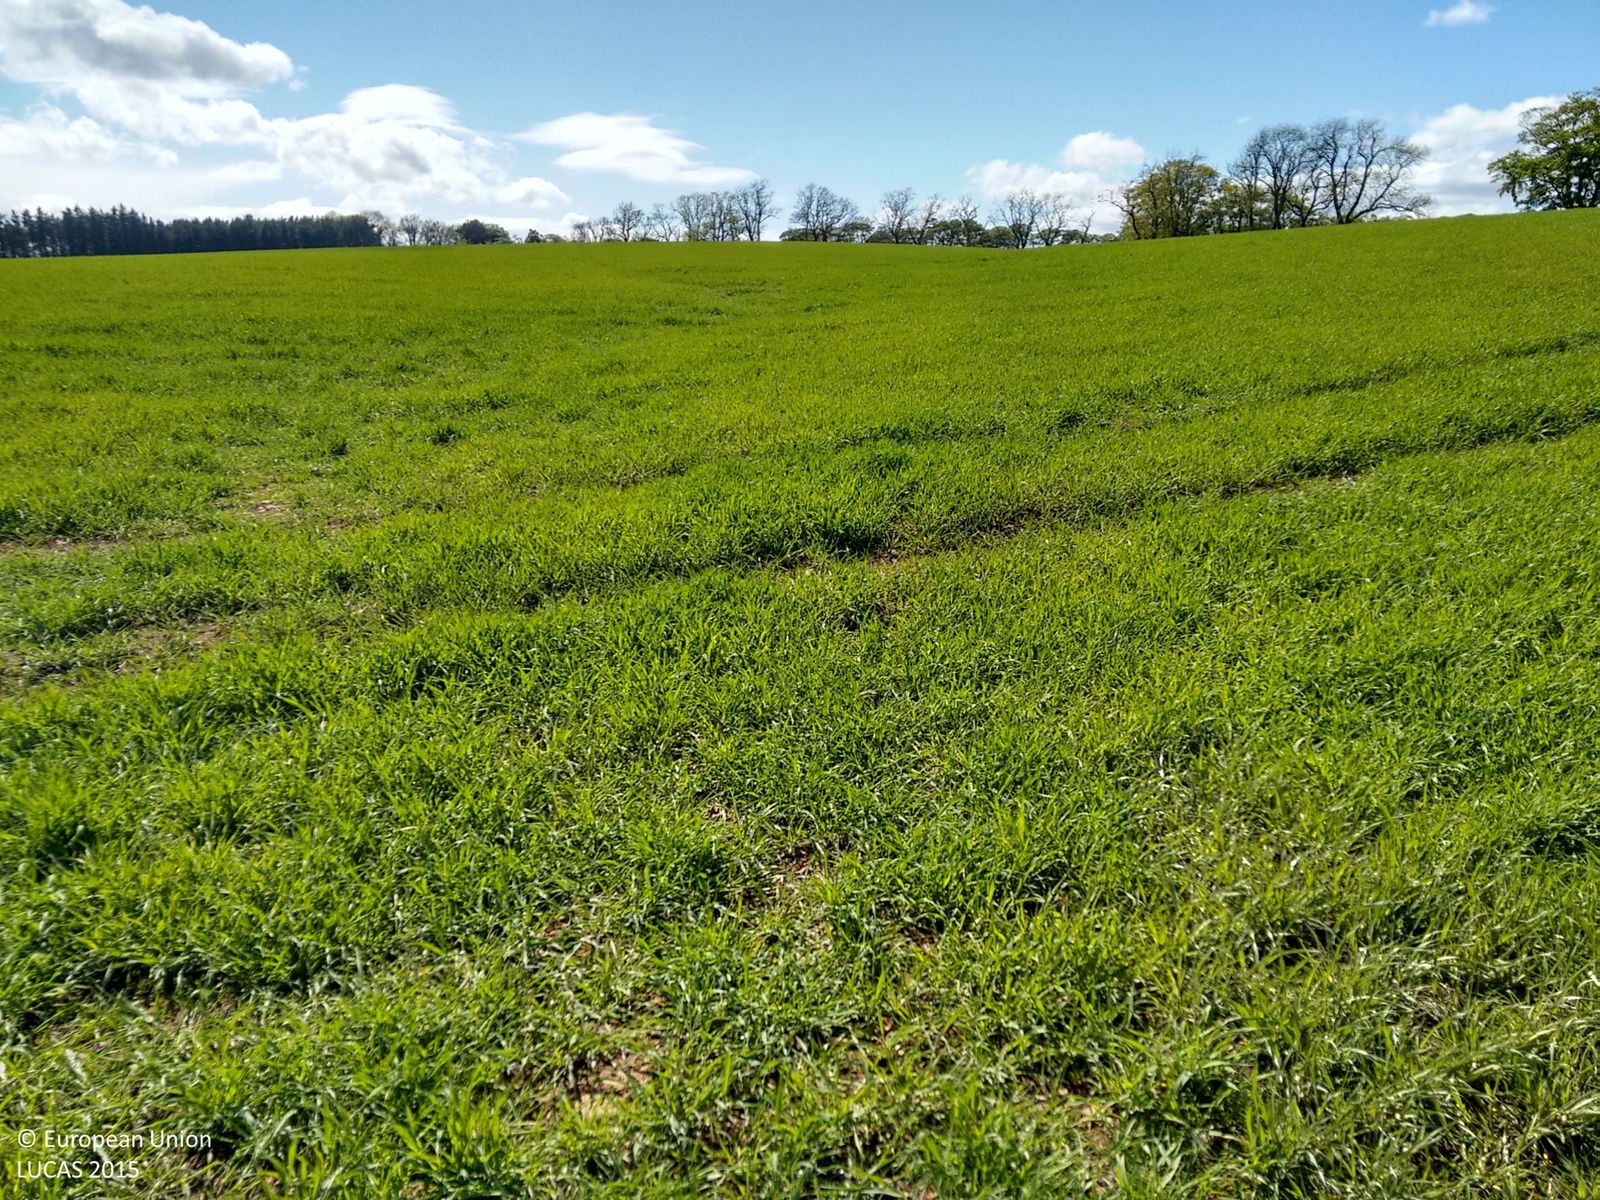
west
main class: Cropland
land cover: Barley
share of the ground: > 75 %
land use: Agriculture (excluding fallow land and kitchen gardens)
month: June
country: GB
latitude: 55.6877
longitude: -2.4508
